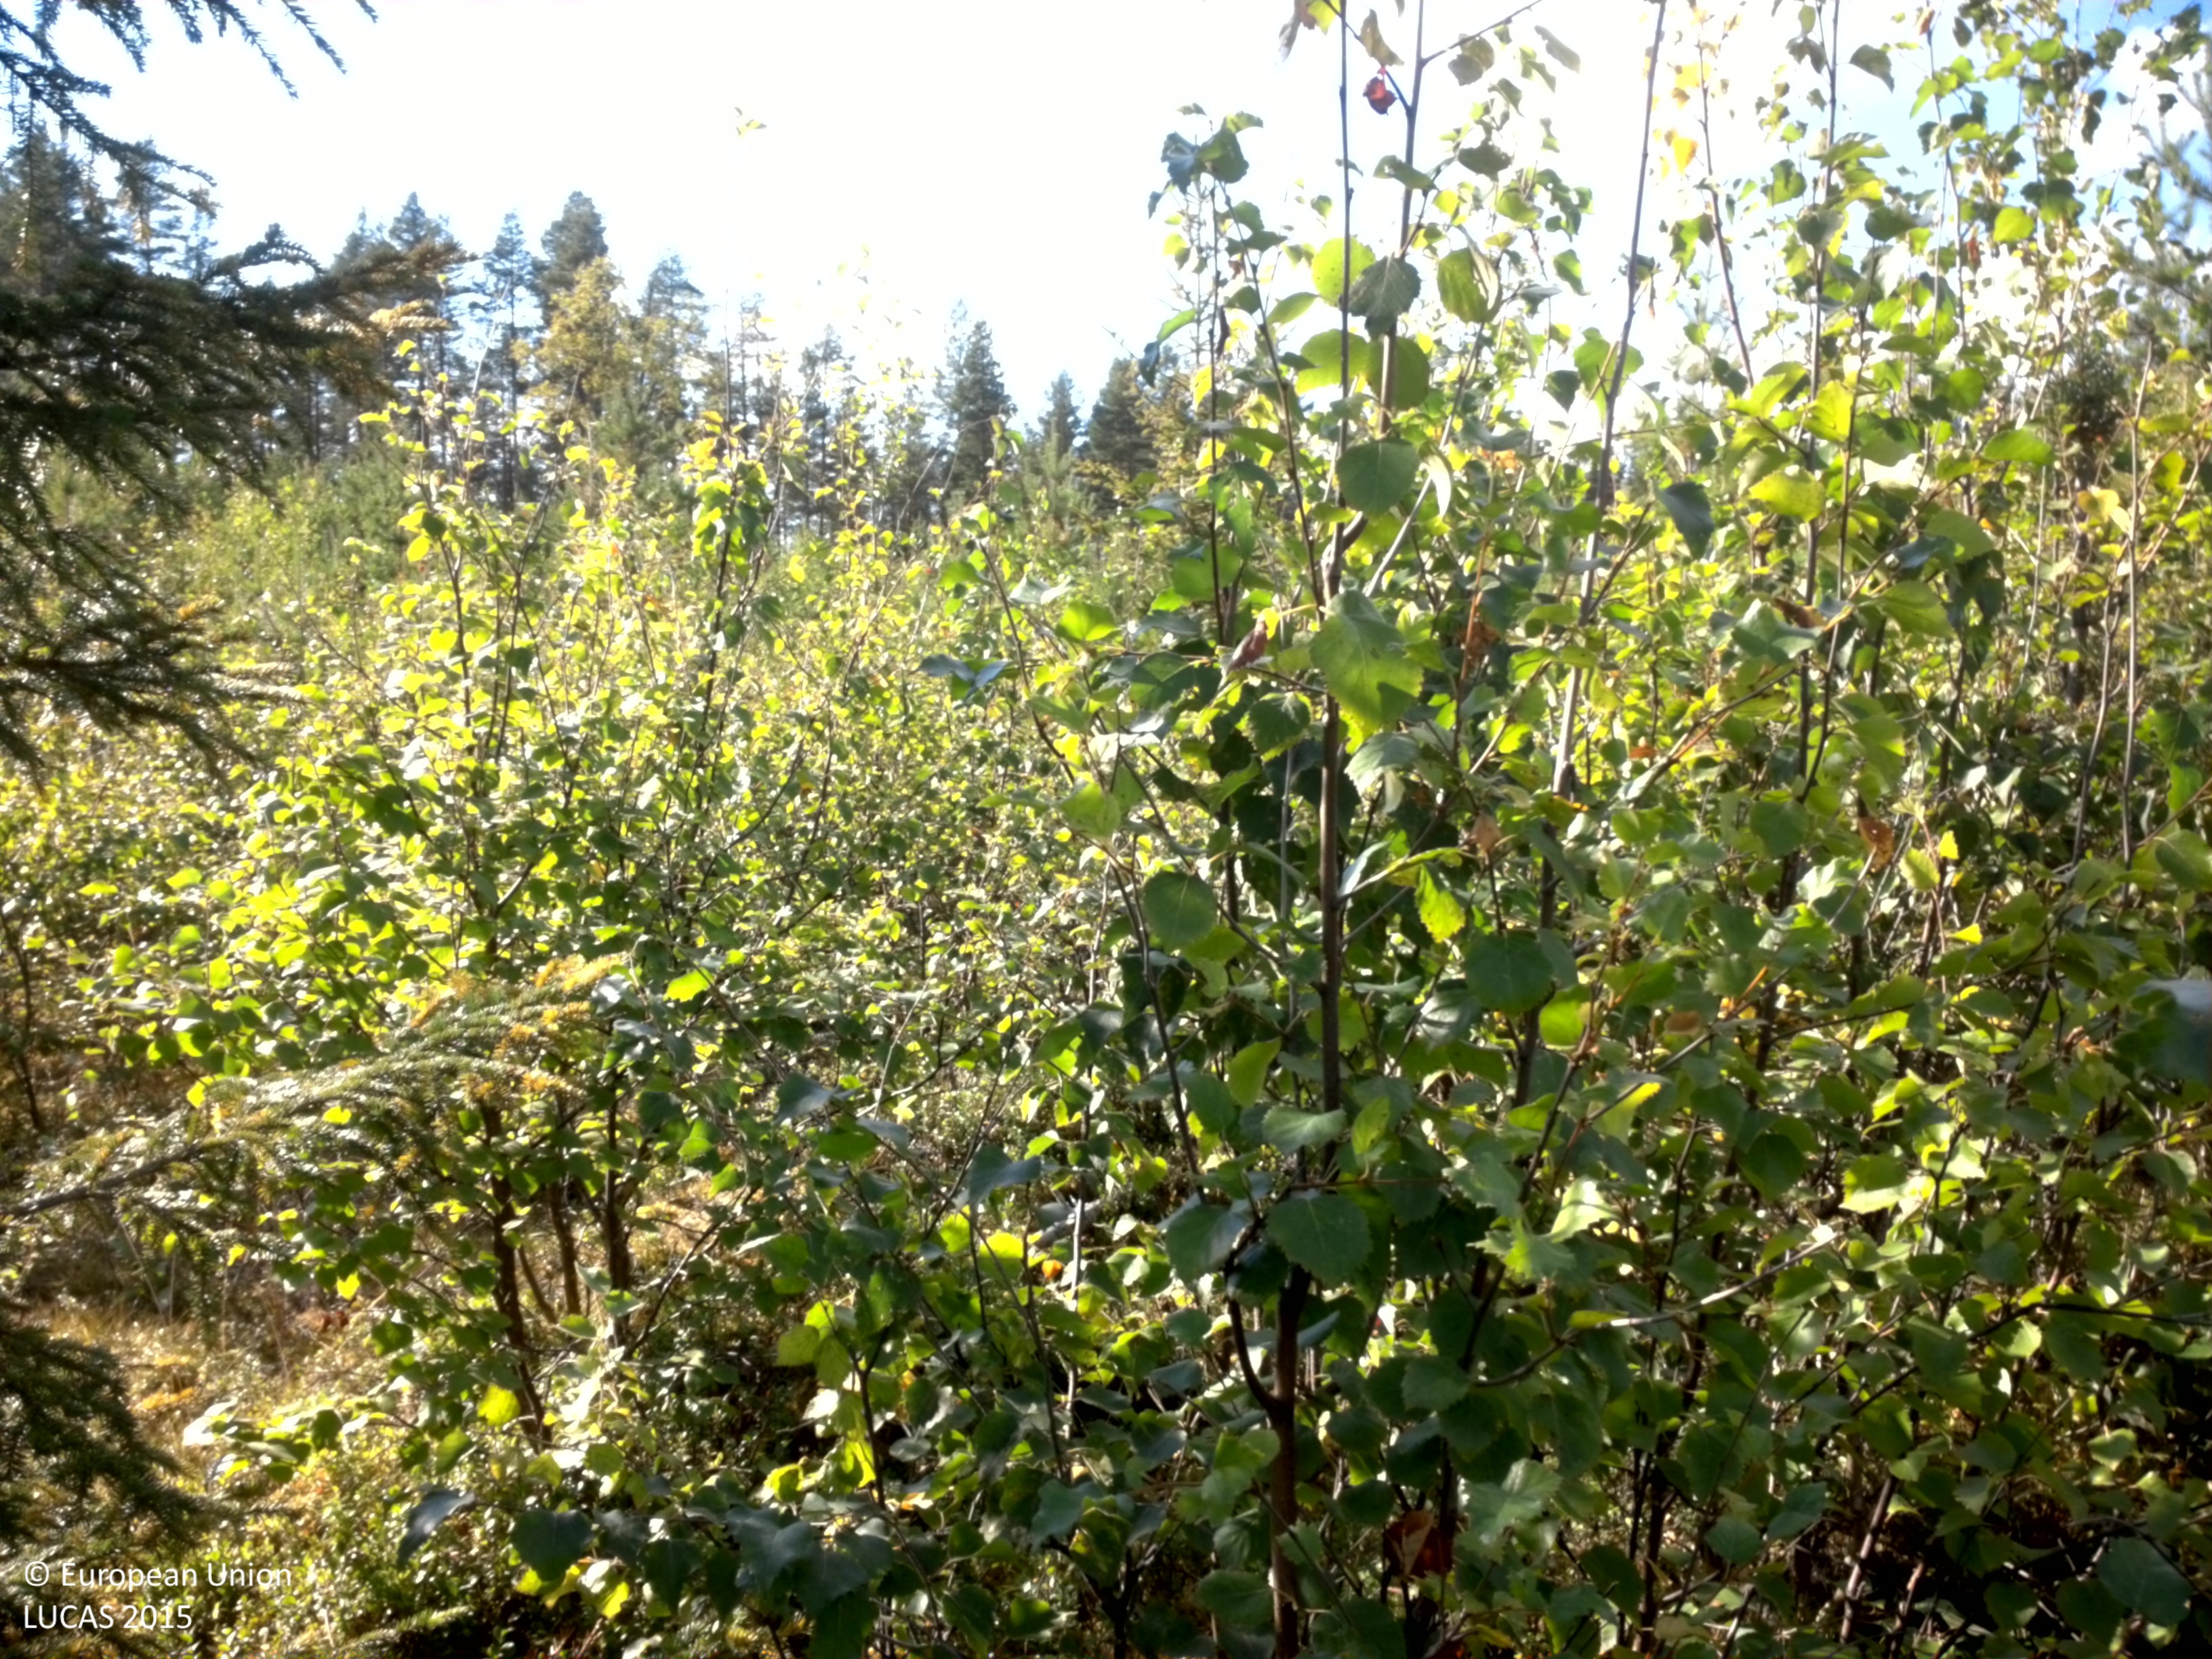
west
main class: Woodland
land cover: Broadleaved woodland
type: boreal forest
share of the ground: > 75 %
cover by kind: broadleaved forest trees 65 %, coniferous forest trees 15 %, herbaceous plants 10 %, shrubs 5 %, lichens and mosses 5 %
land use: Forestry
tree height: > 5 m
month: August
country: SE
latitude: 64.5226
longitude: 19.0331
